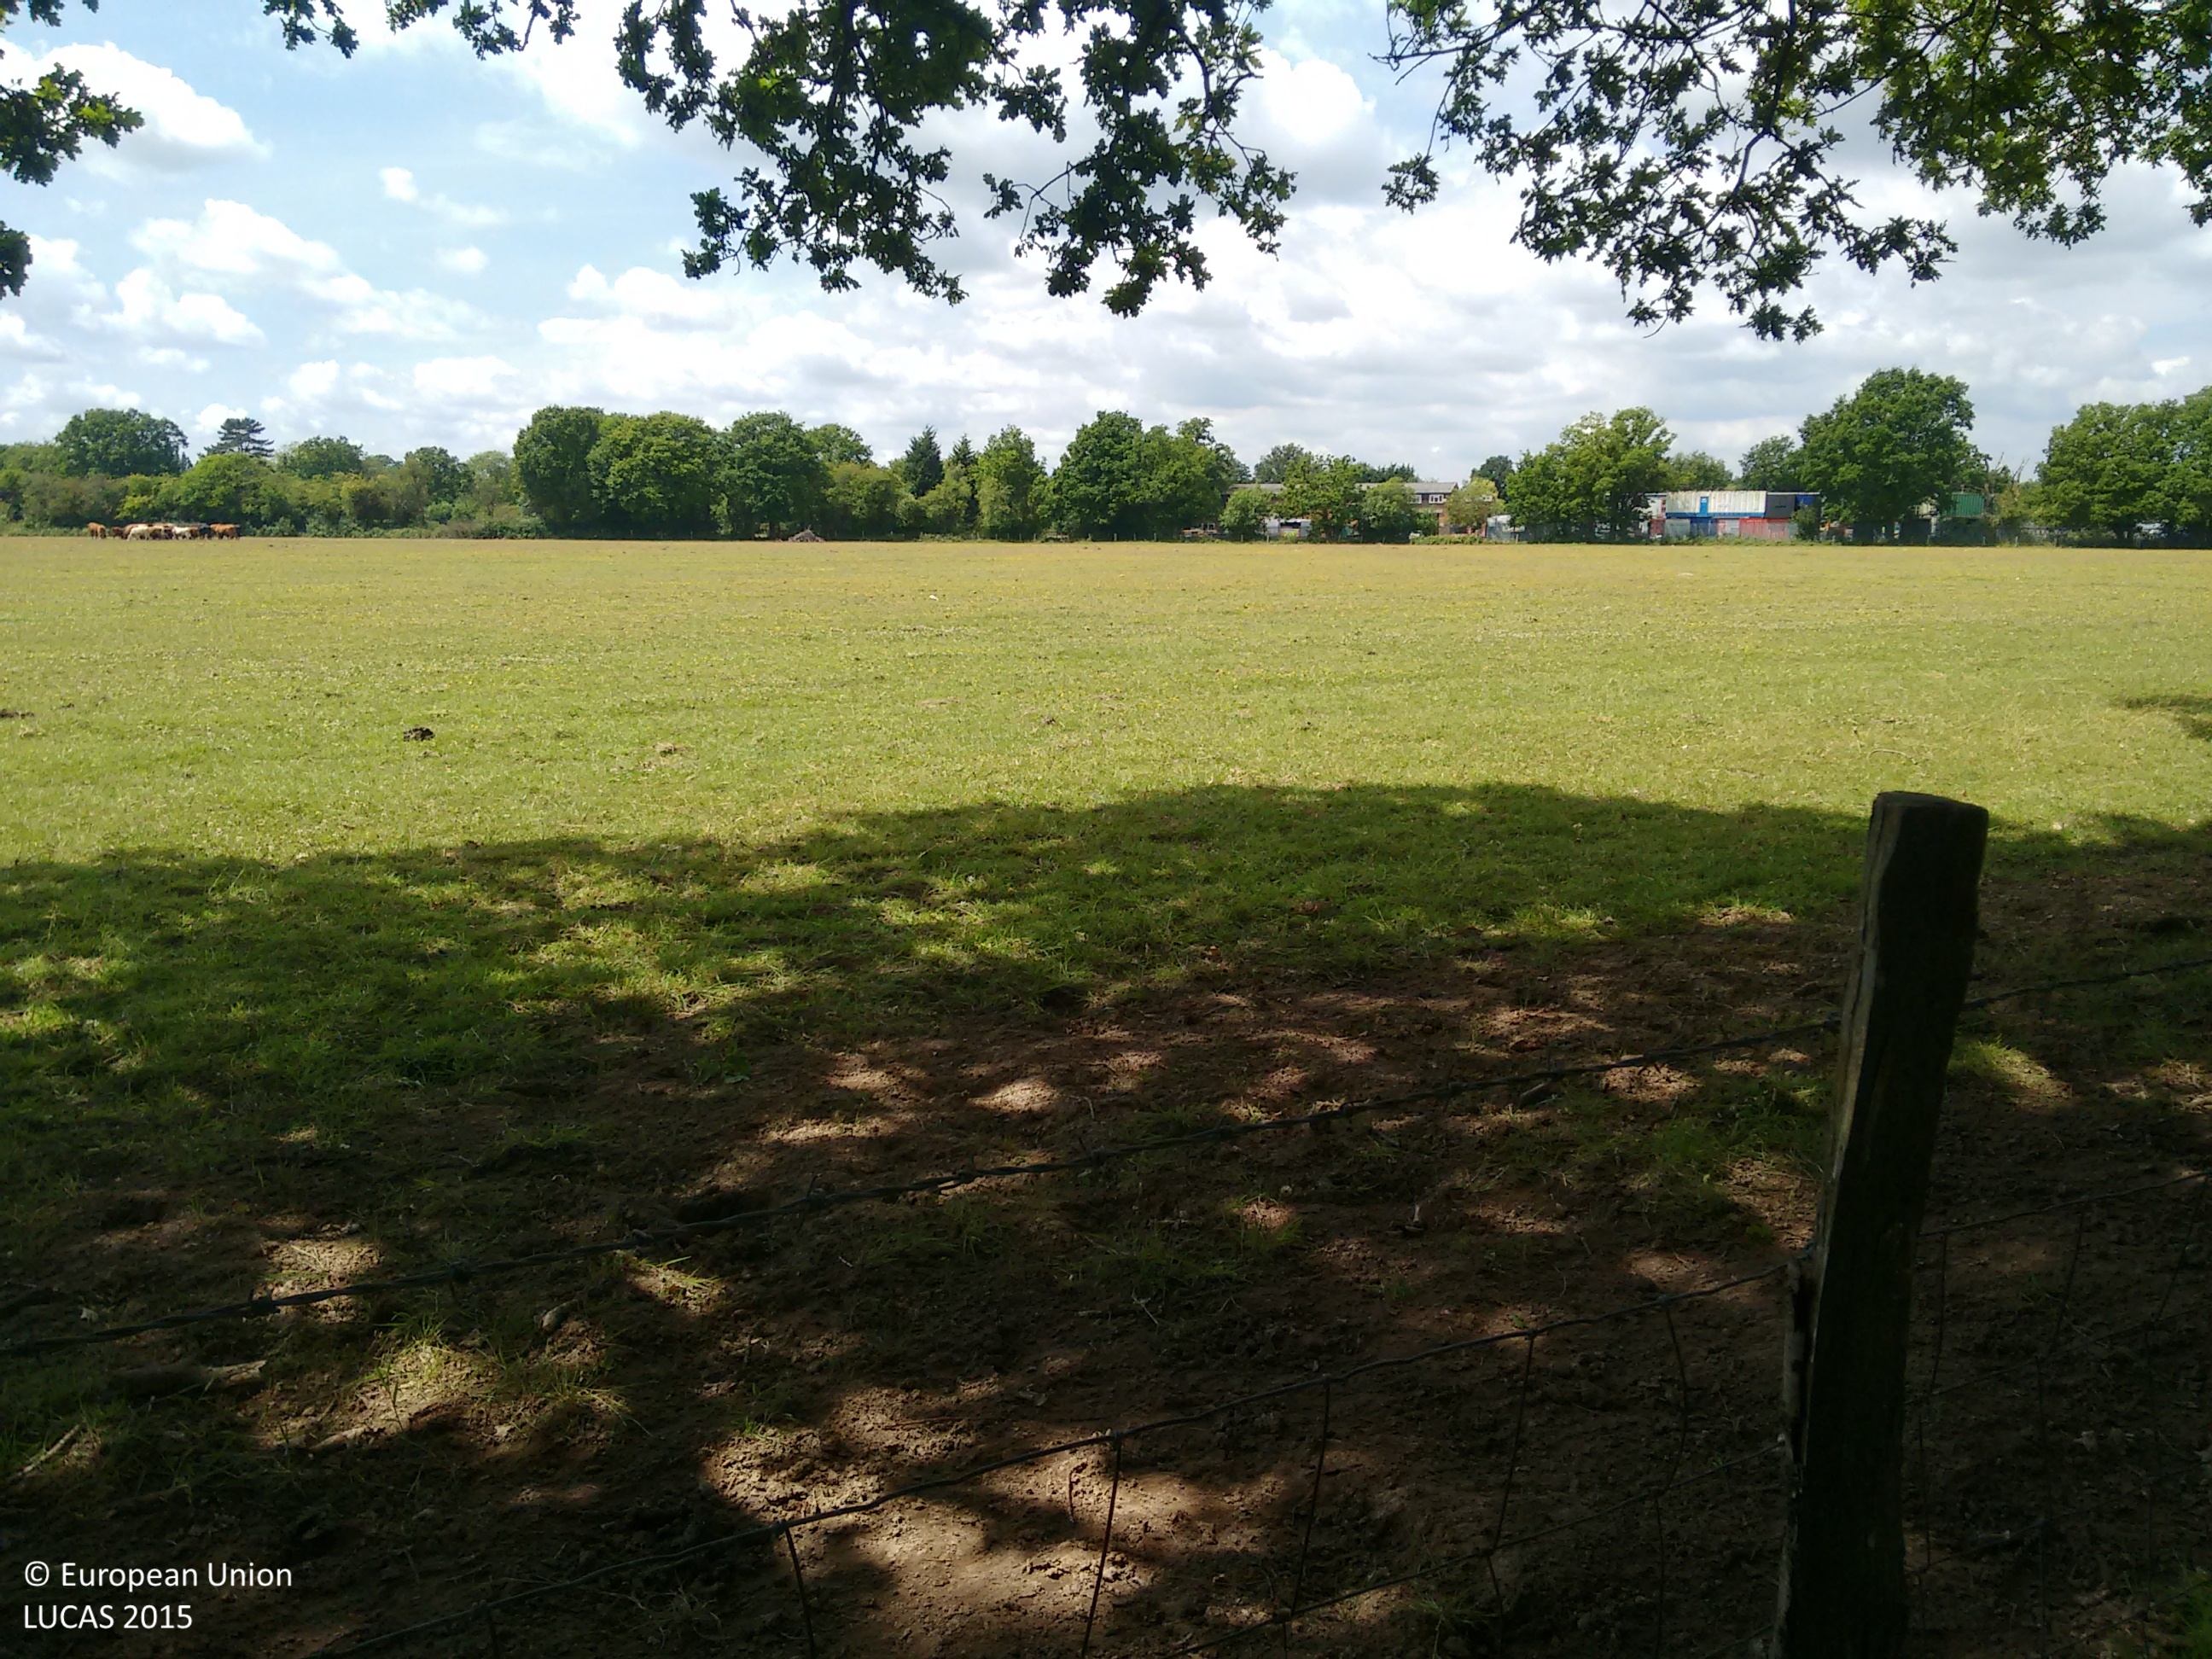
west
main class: Grassland
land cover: Grassland without tree/shrub cover
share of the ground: > 75 %
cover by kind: herbaceous plants 100 %
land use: Agriculture (excluding fallow land and kitchen gardens)
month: June
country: GB
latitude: 51.1625
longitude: -0.1444
